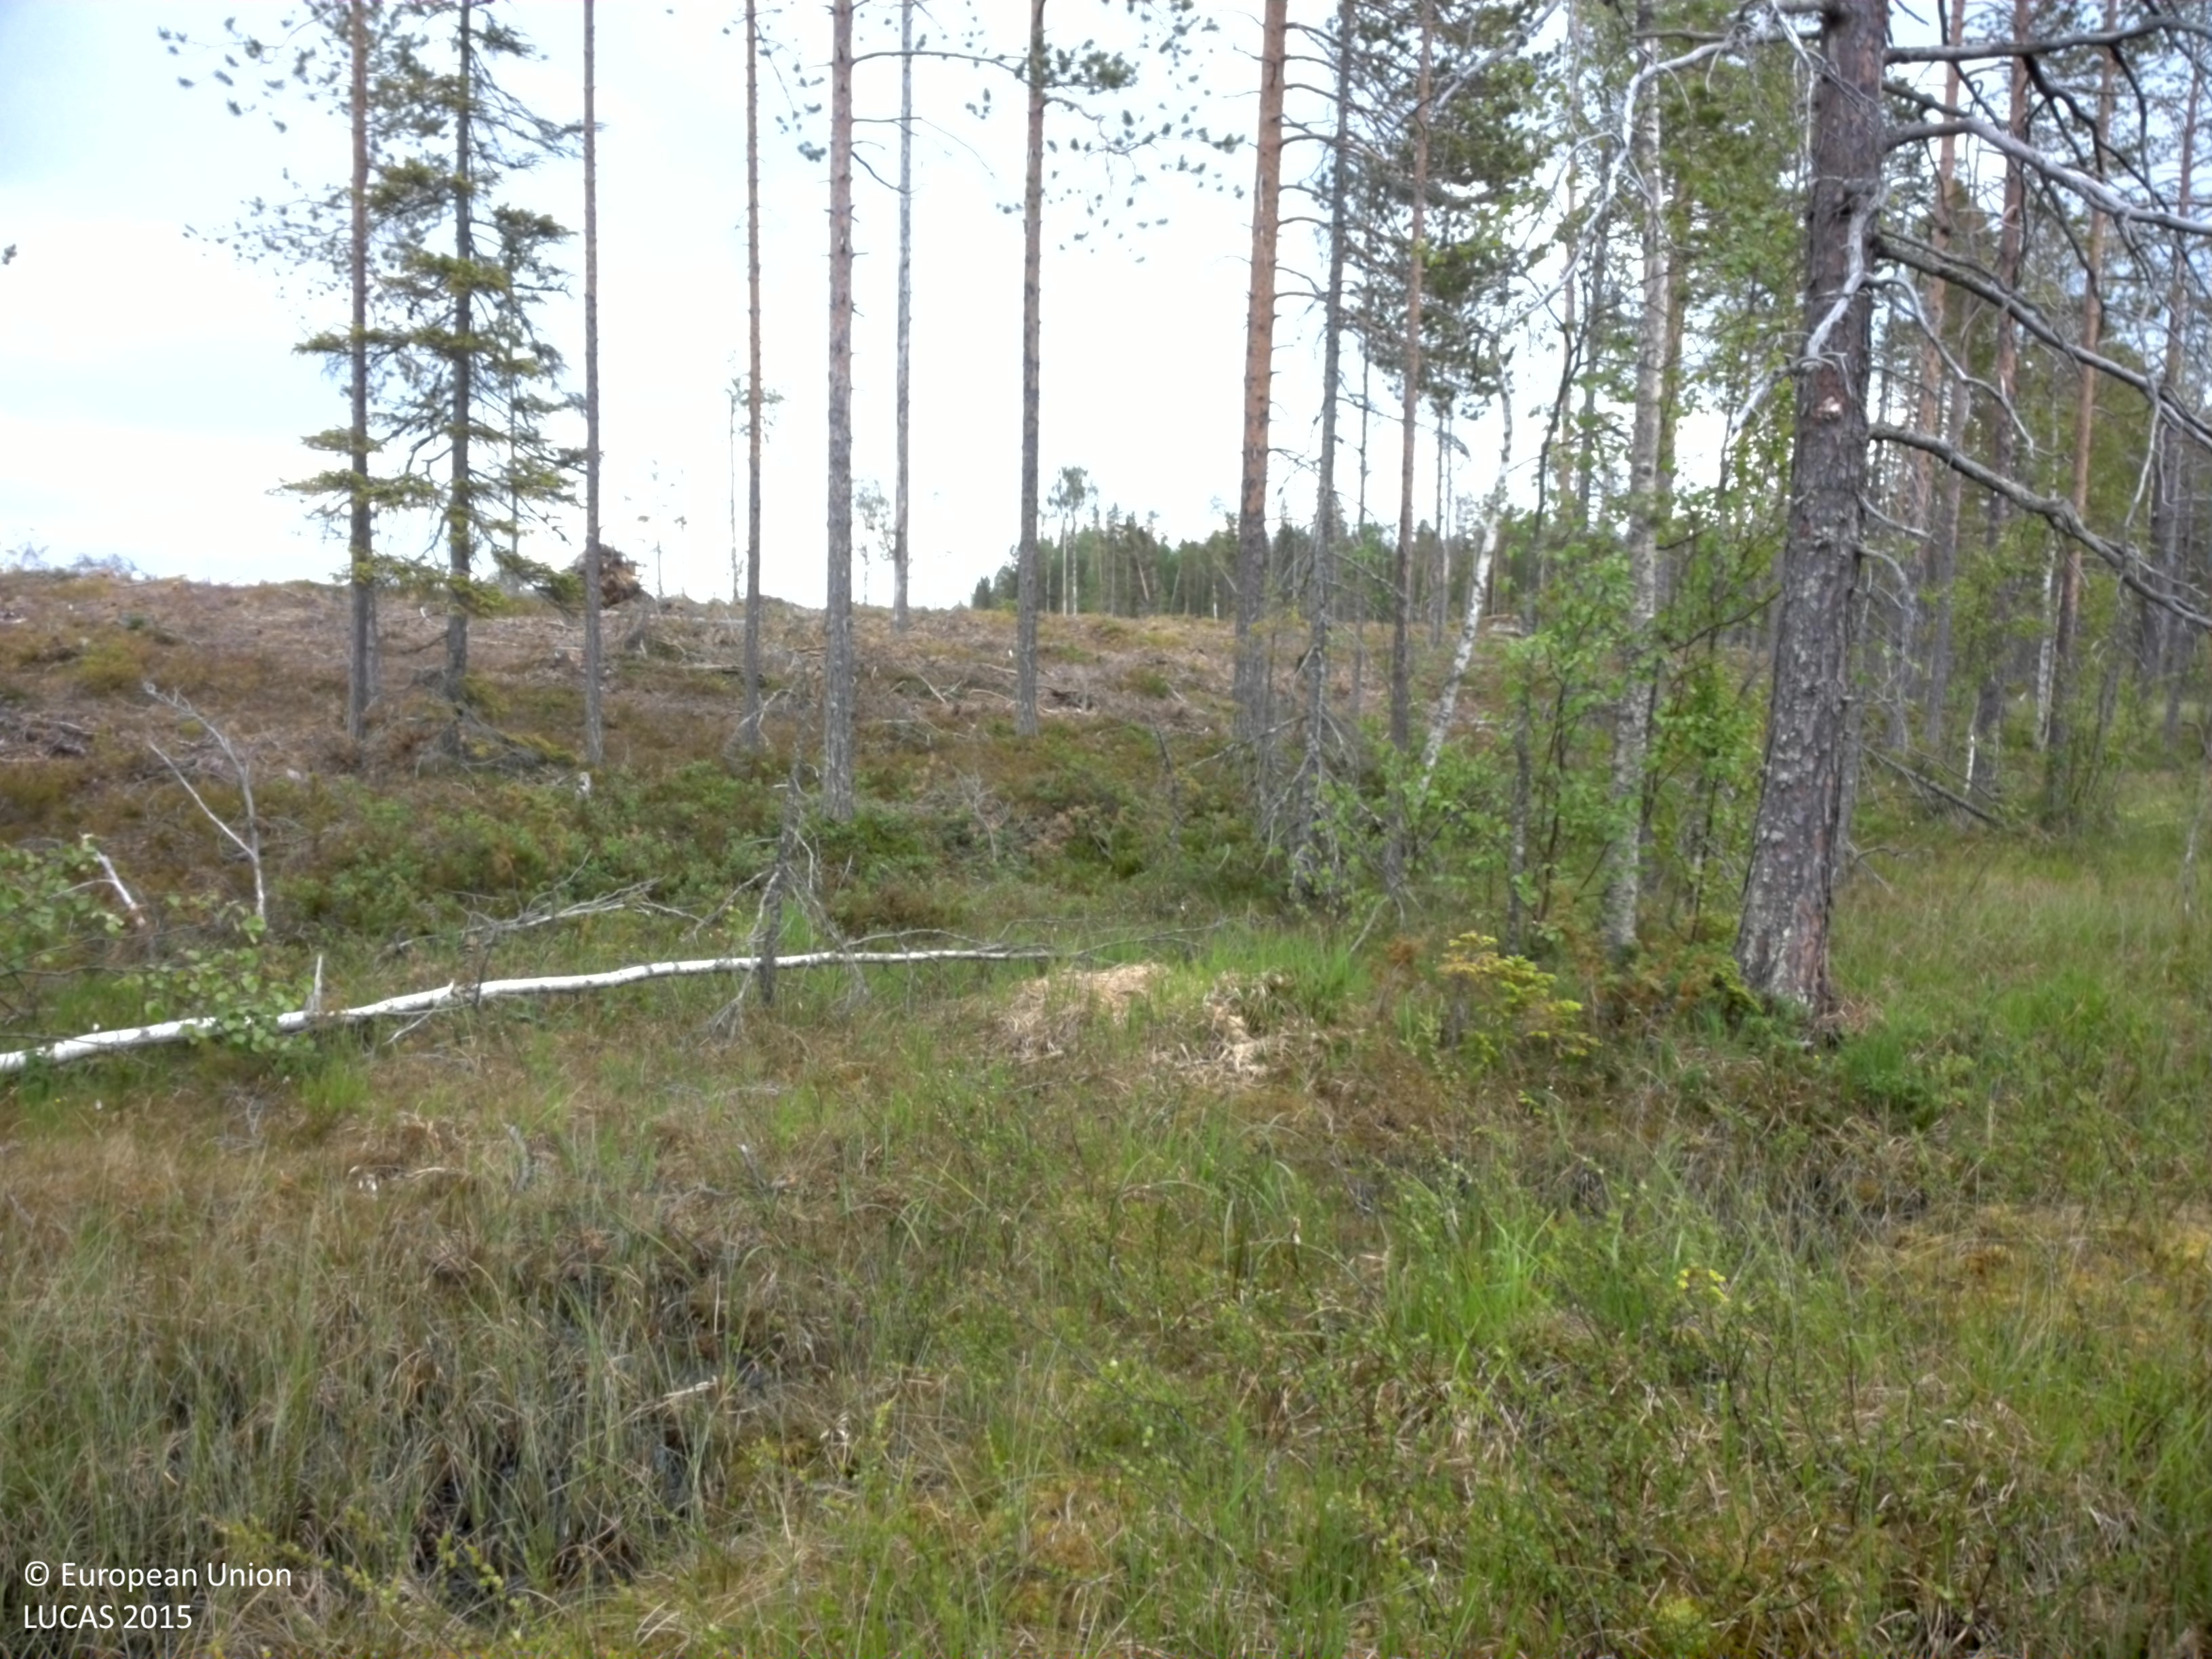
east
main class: Woodland
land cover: Pine dominated coniferous woodland
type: mire and swamp forests
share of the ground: 10 - 25 %
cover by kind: herbaceous plants 45 %, shrubs 25 %, coniferous forest trees 20 %, broadleaved forest trees 5 %, lichens and mosses 5 %
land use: Semi-natural and natural areas not in use
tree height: < 5 m
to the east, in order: Pine dominated coniferous woodland; Shrubland with sparse tree cover; Ditches and canals; Paved roads, cycling and walking lanes; Rocks and stones; Shrubland with sparse tree cover; Grassland with sparse tree/shrub cover
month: July
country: SE
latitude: 64.4128
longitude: 20.7921
